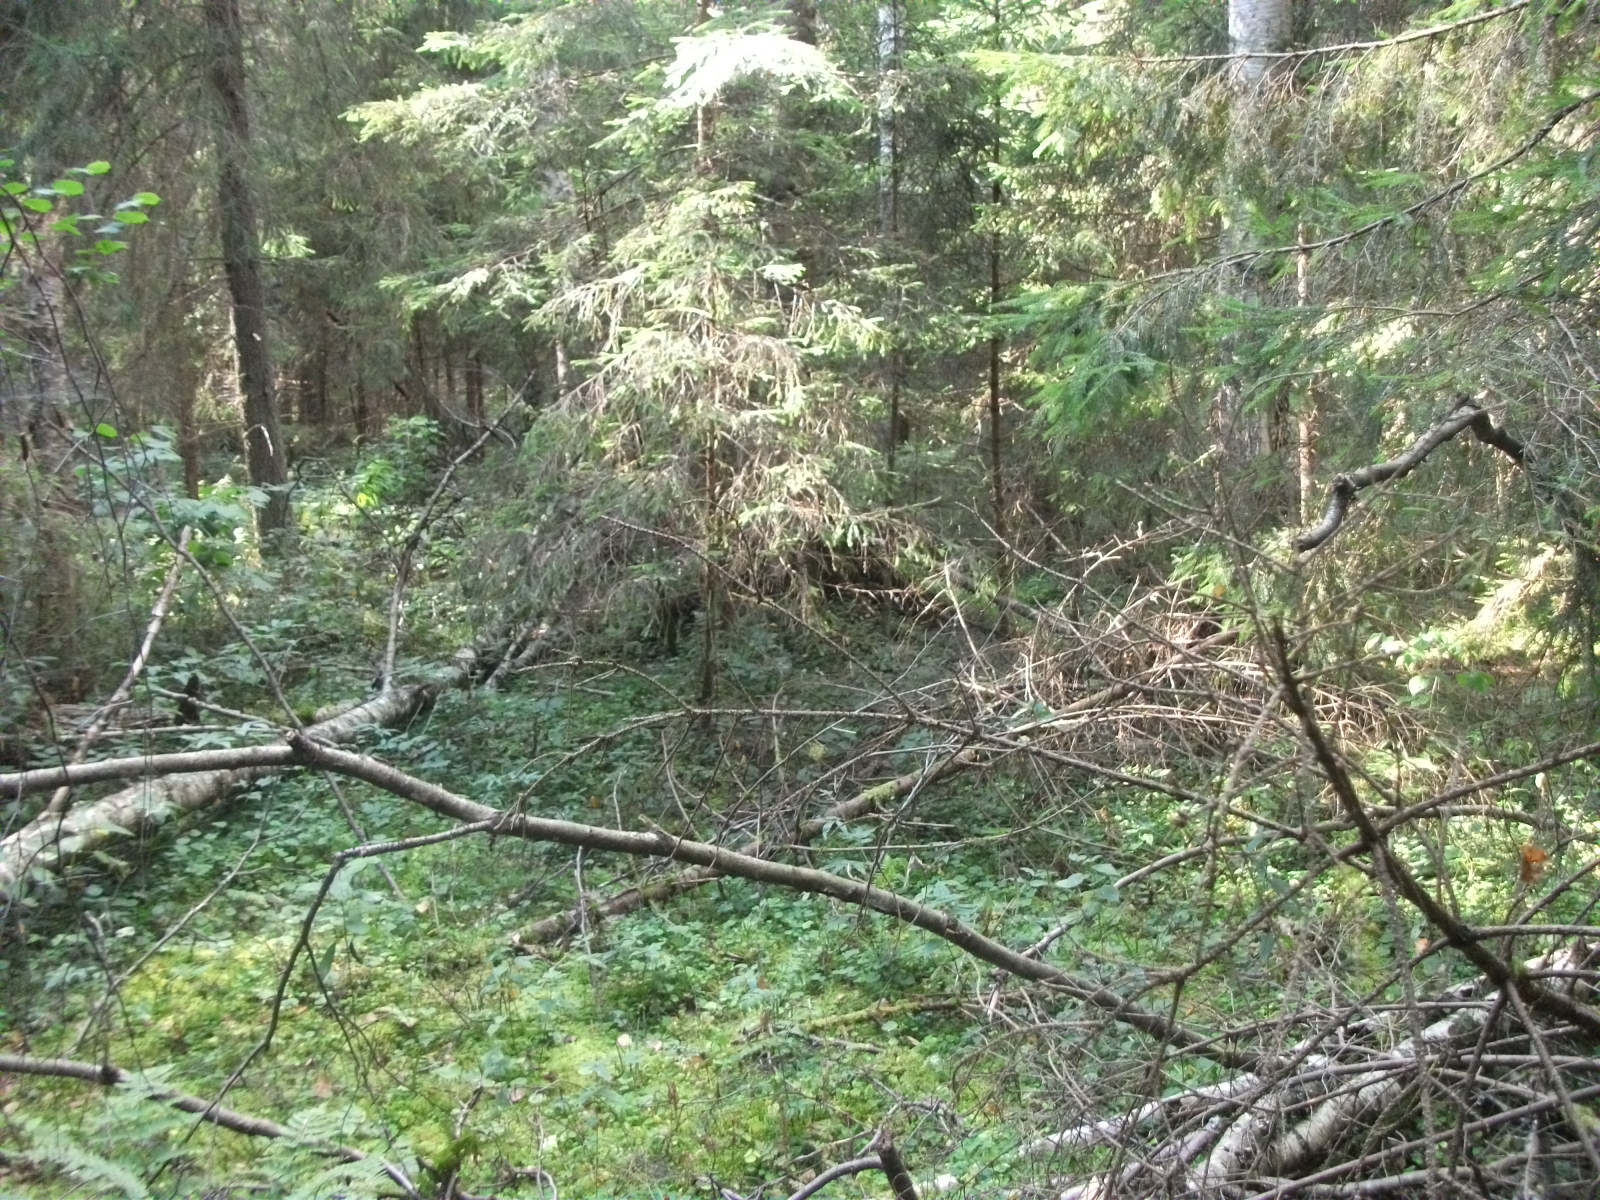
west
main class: Woodland
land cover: Spruce dominated mixed woodland
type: hemiboreal forest and nemoral coniferous forest and mixed broadleaved-coniferous forest
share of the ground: > 75 %
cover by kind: coniferous forest trees 60 %, broadleaved forest trees 30 %, shrubs 5 %, herbaceous plants 5 %
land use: Forestry
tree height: > 5 m
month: August
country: LV
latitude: 56.8184
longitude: 26.5132
